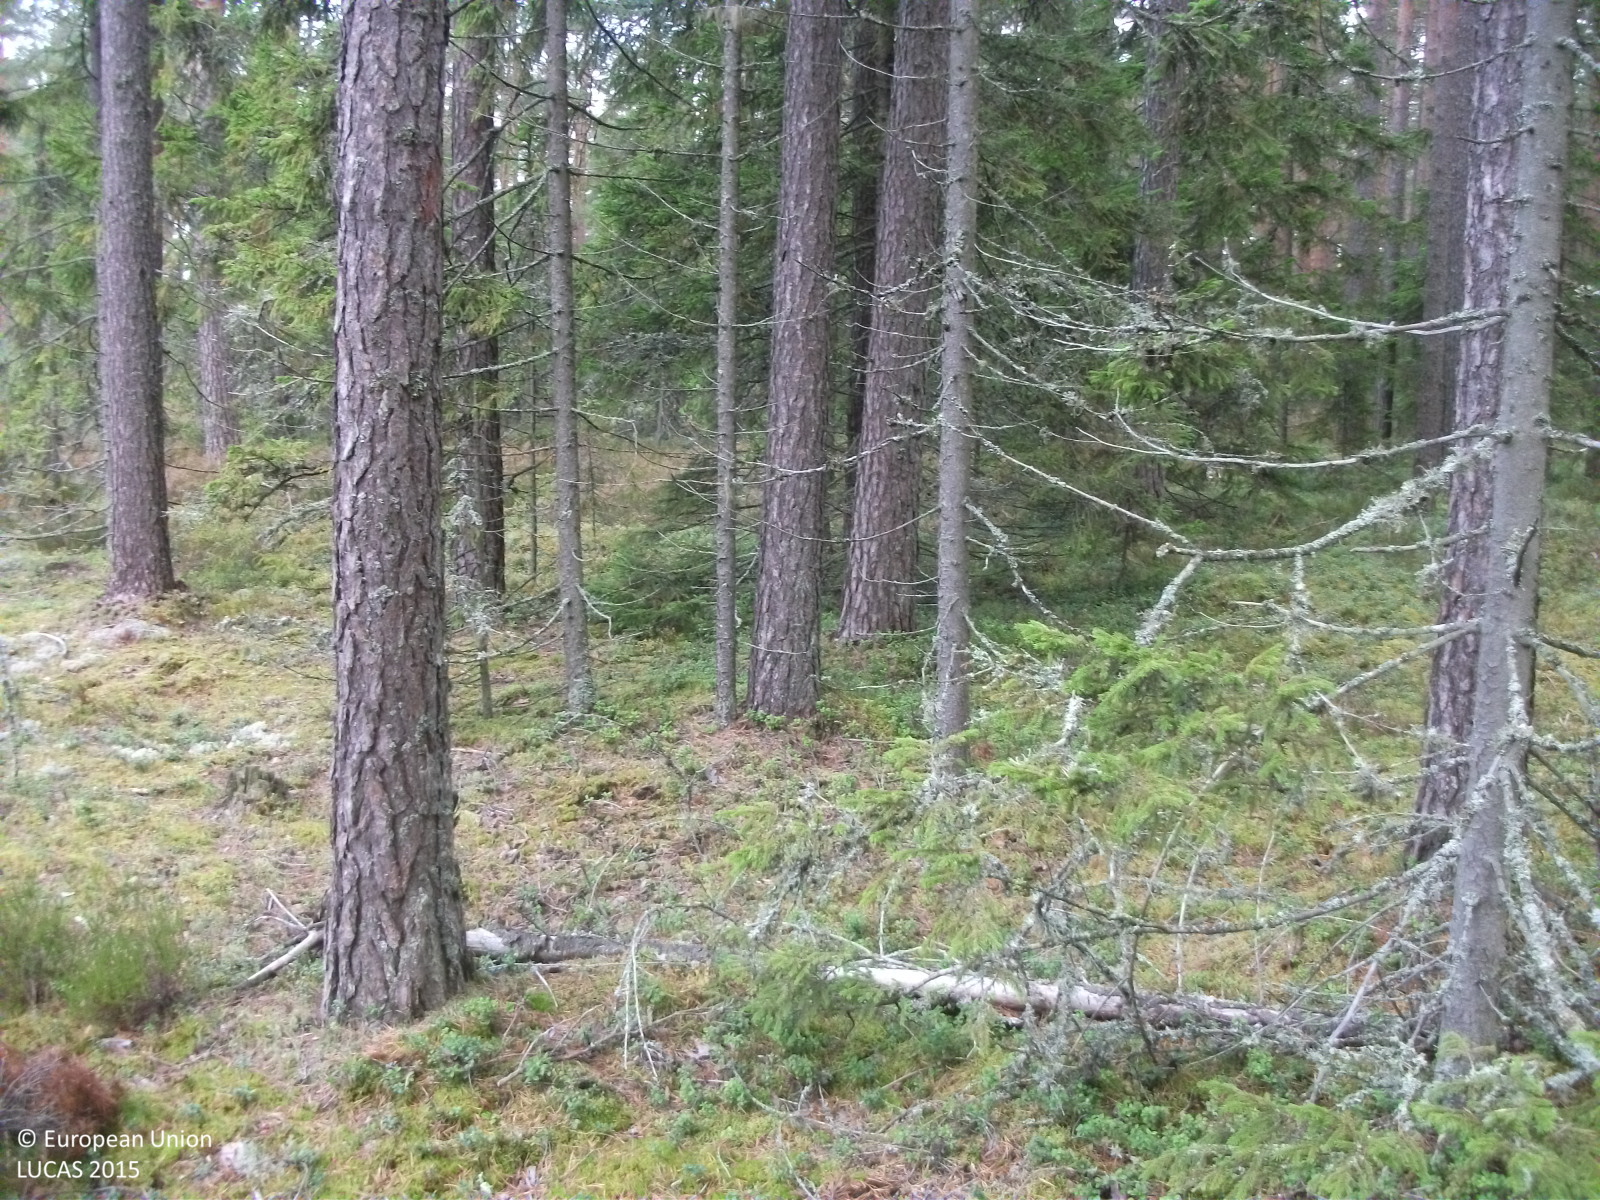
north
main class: Woodland
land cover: Pine dominated coniferous woodland
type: hemiboreal forest and nemoral coniferous forest and mixed broadleaved-coniferous forest
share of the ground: > 75 %
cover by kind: coniferous forest trees 80 %, lichens and mosses 15 %, herbaceous plants 5 %
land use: Forestry
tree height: > 5 m
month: September
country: LV
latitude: 57.6876
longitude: 24.4640
